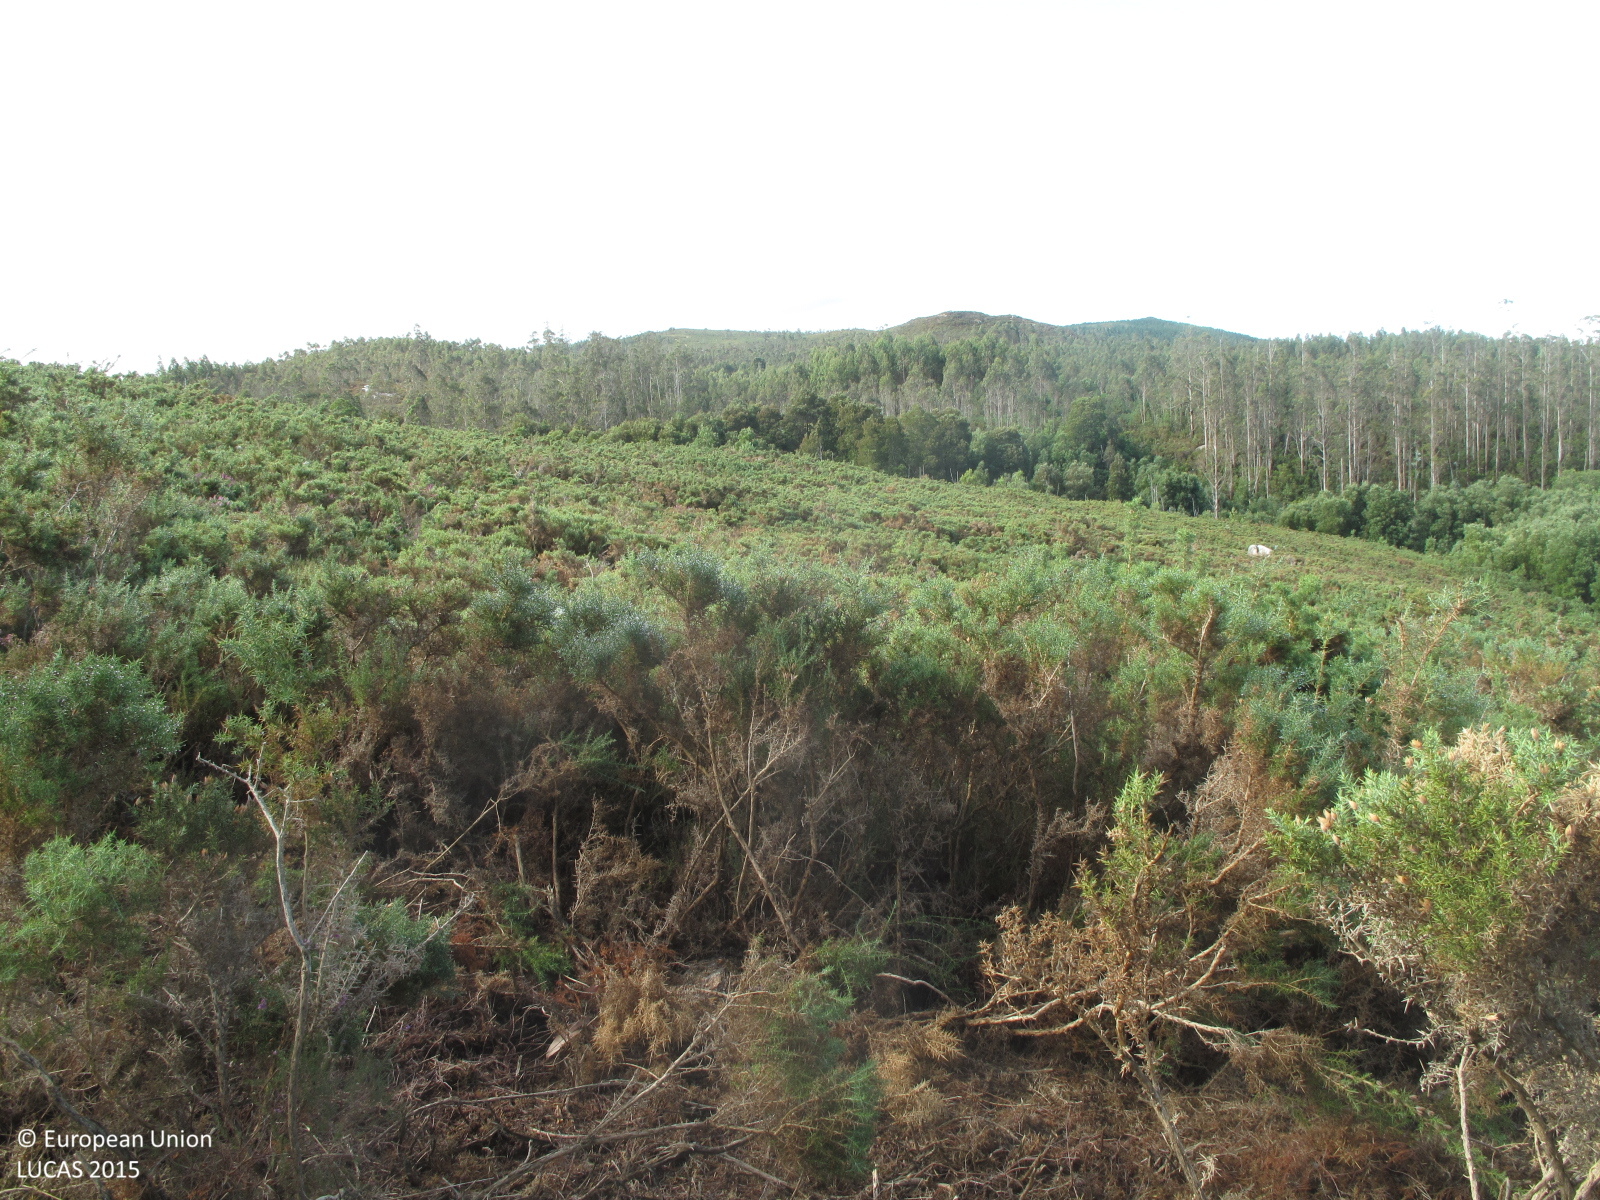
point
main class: Shrubland
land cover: Shrubland without tree cover
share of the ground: > 75 %
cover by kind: shrubs 100 %
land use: Abandoned areas
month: July
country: ES
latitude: 43.0517
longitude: -9.1184
